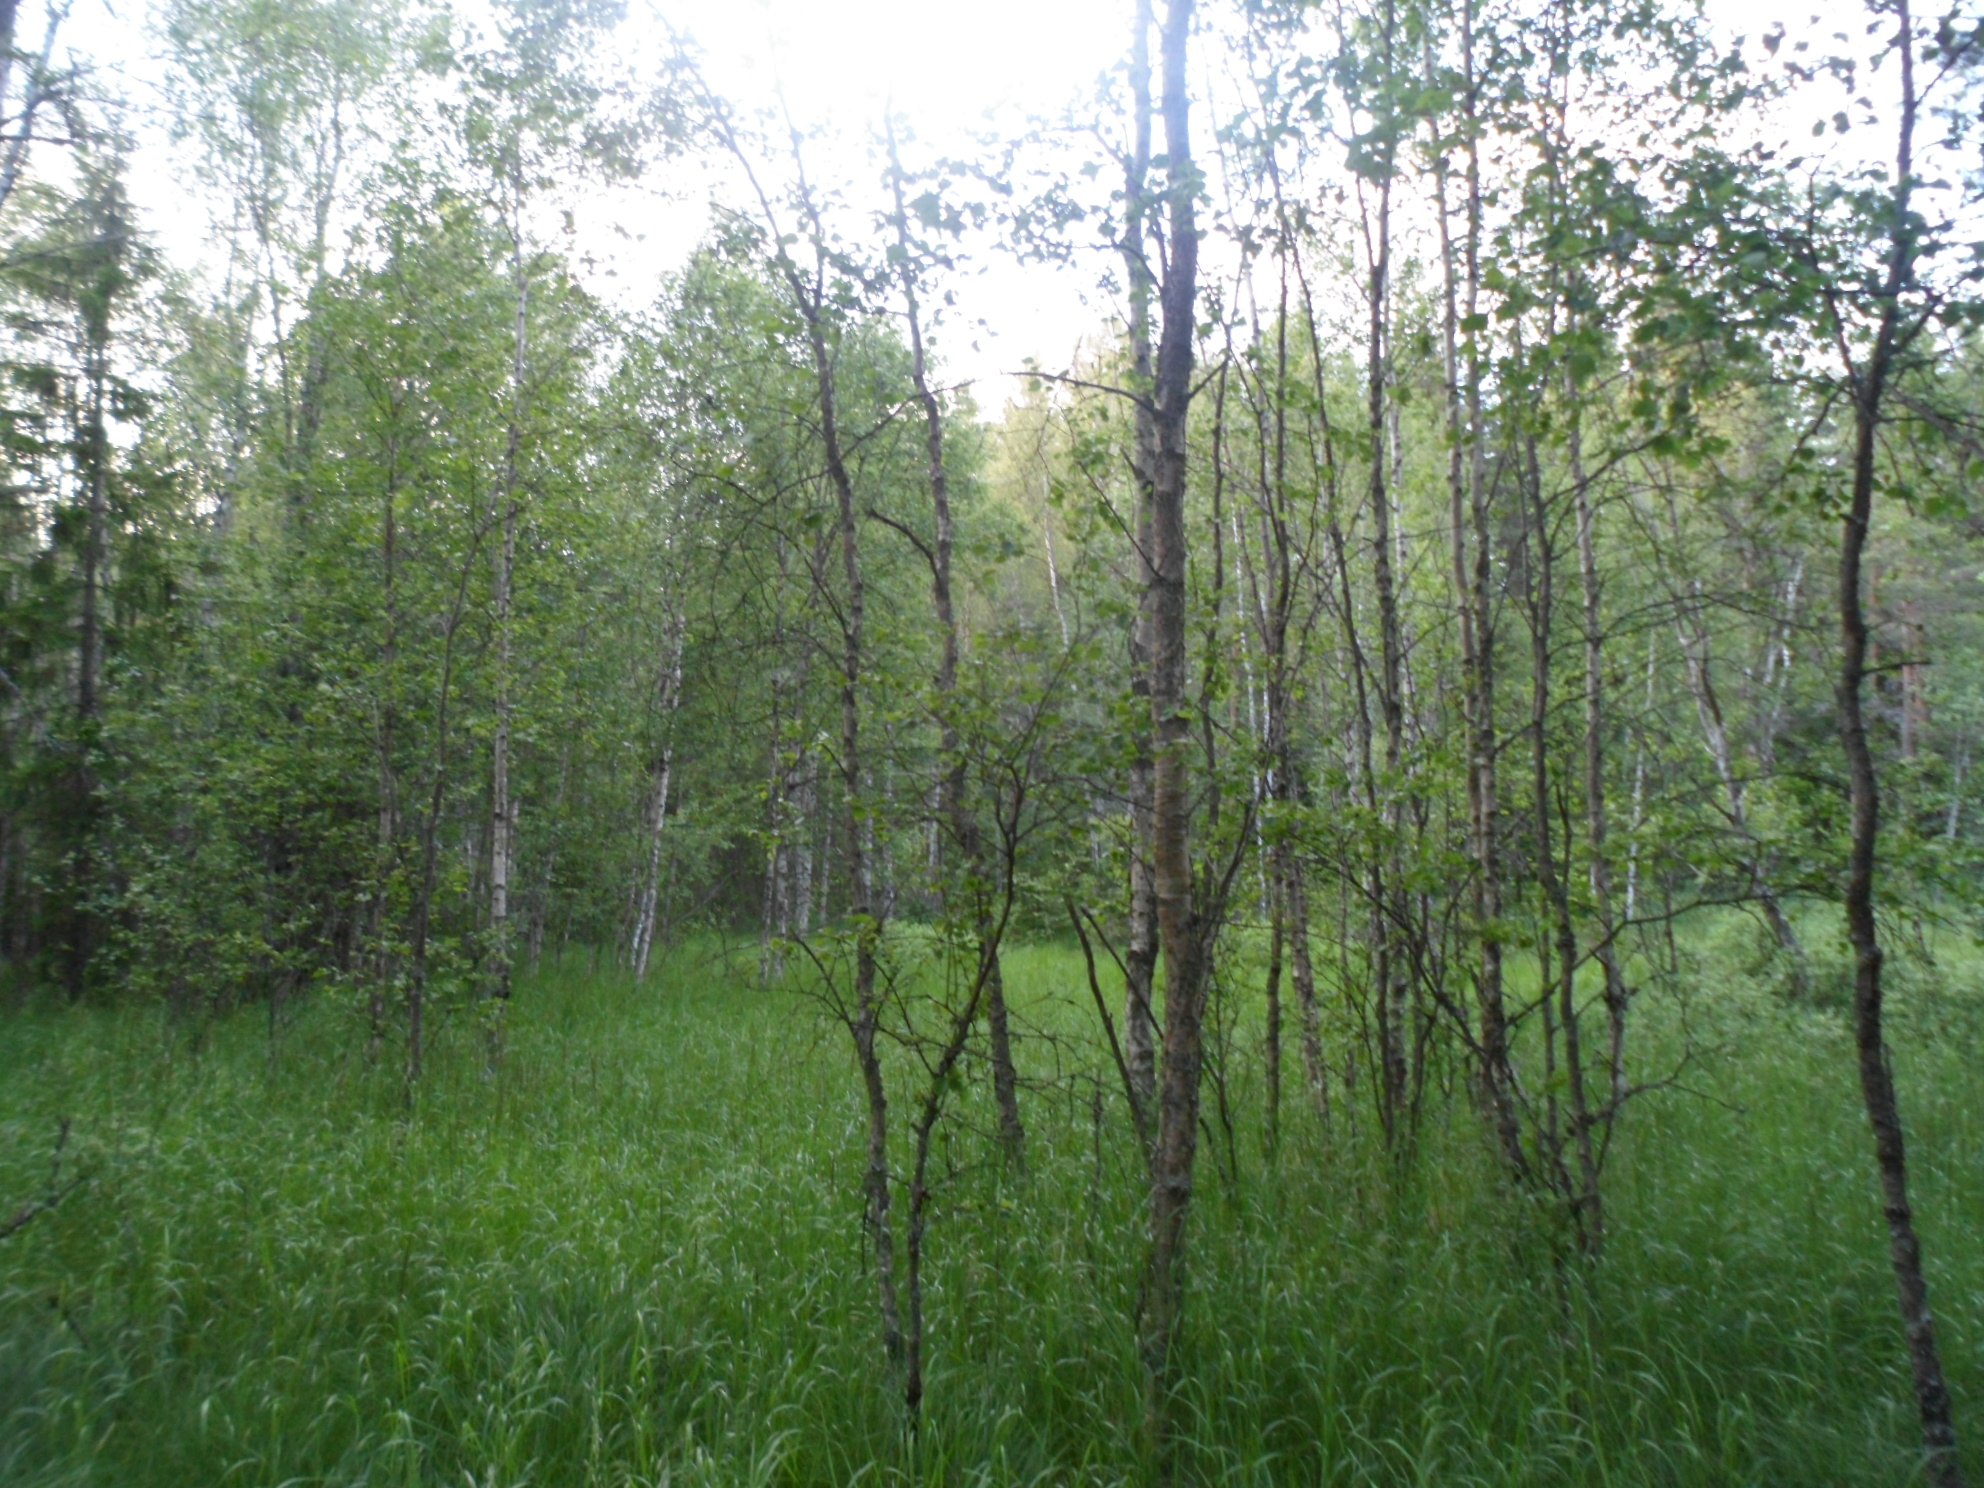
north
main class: Woodland
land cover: Broadleaved woodland
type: mire and swamp forests
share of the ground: 50 - 75 %
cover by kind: broadleaved forest trees 60 %, herbaceous plants 25 %, lichens and mosses 10 %, shrubs 5 %
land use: Forestry
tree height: > 5 m
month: June
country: SE
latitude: 57.1044
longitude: 15.3298
